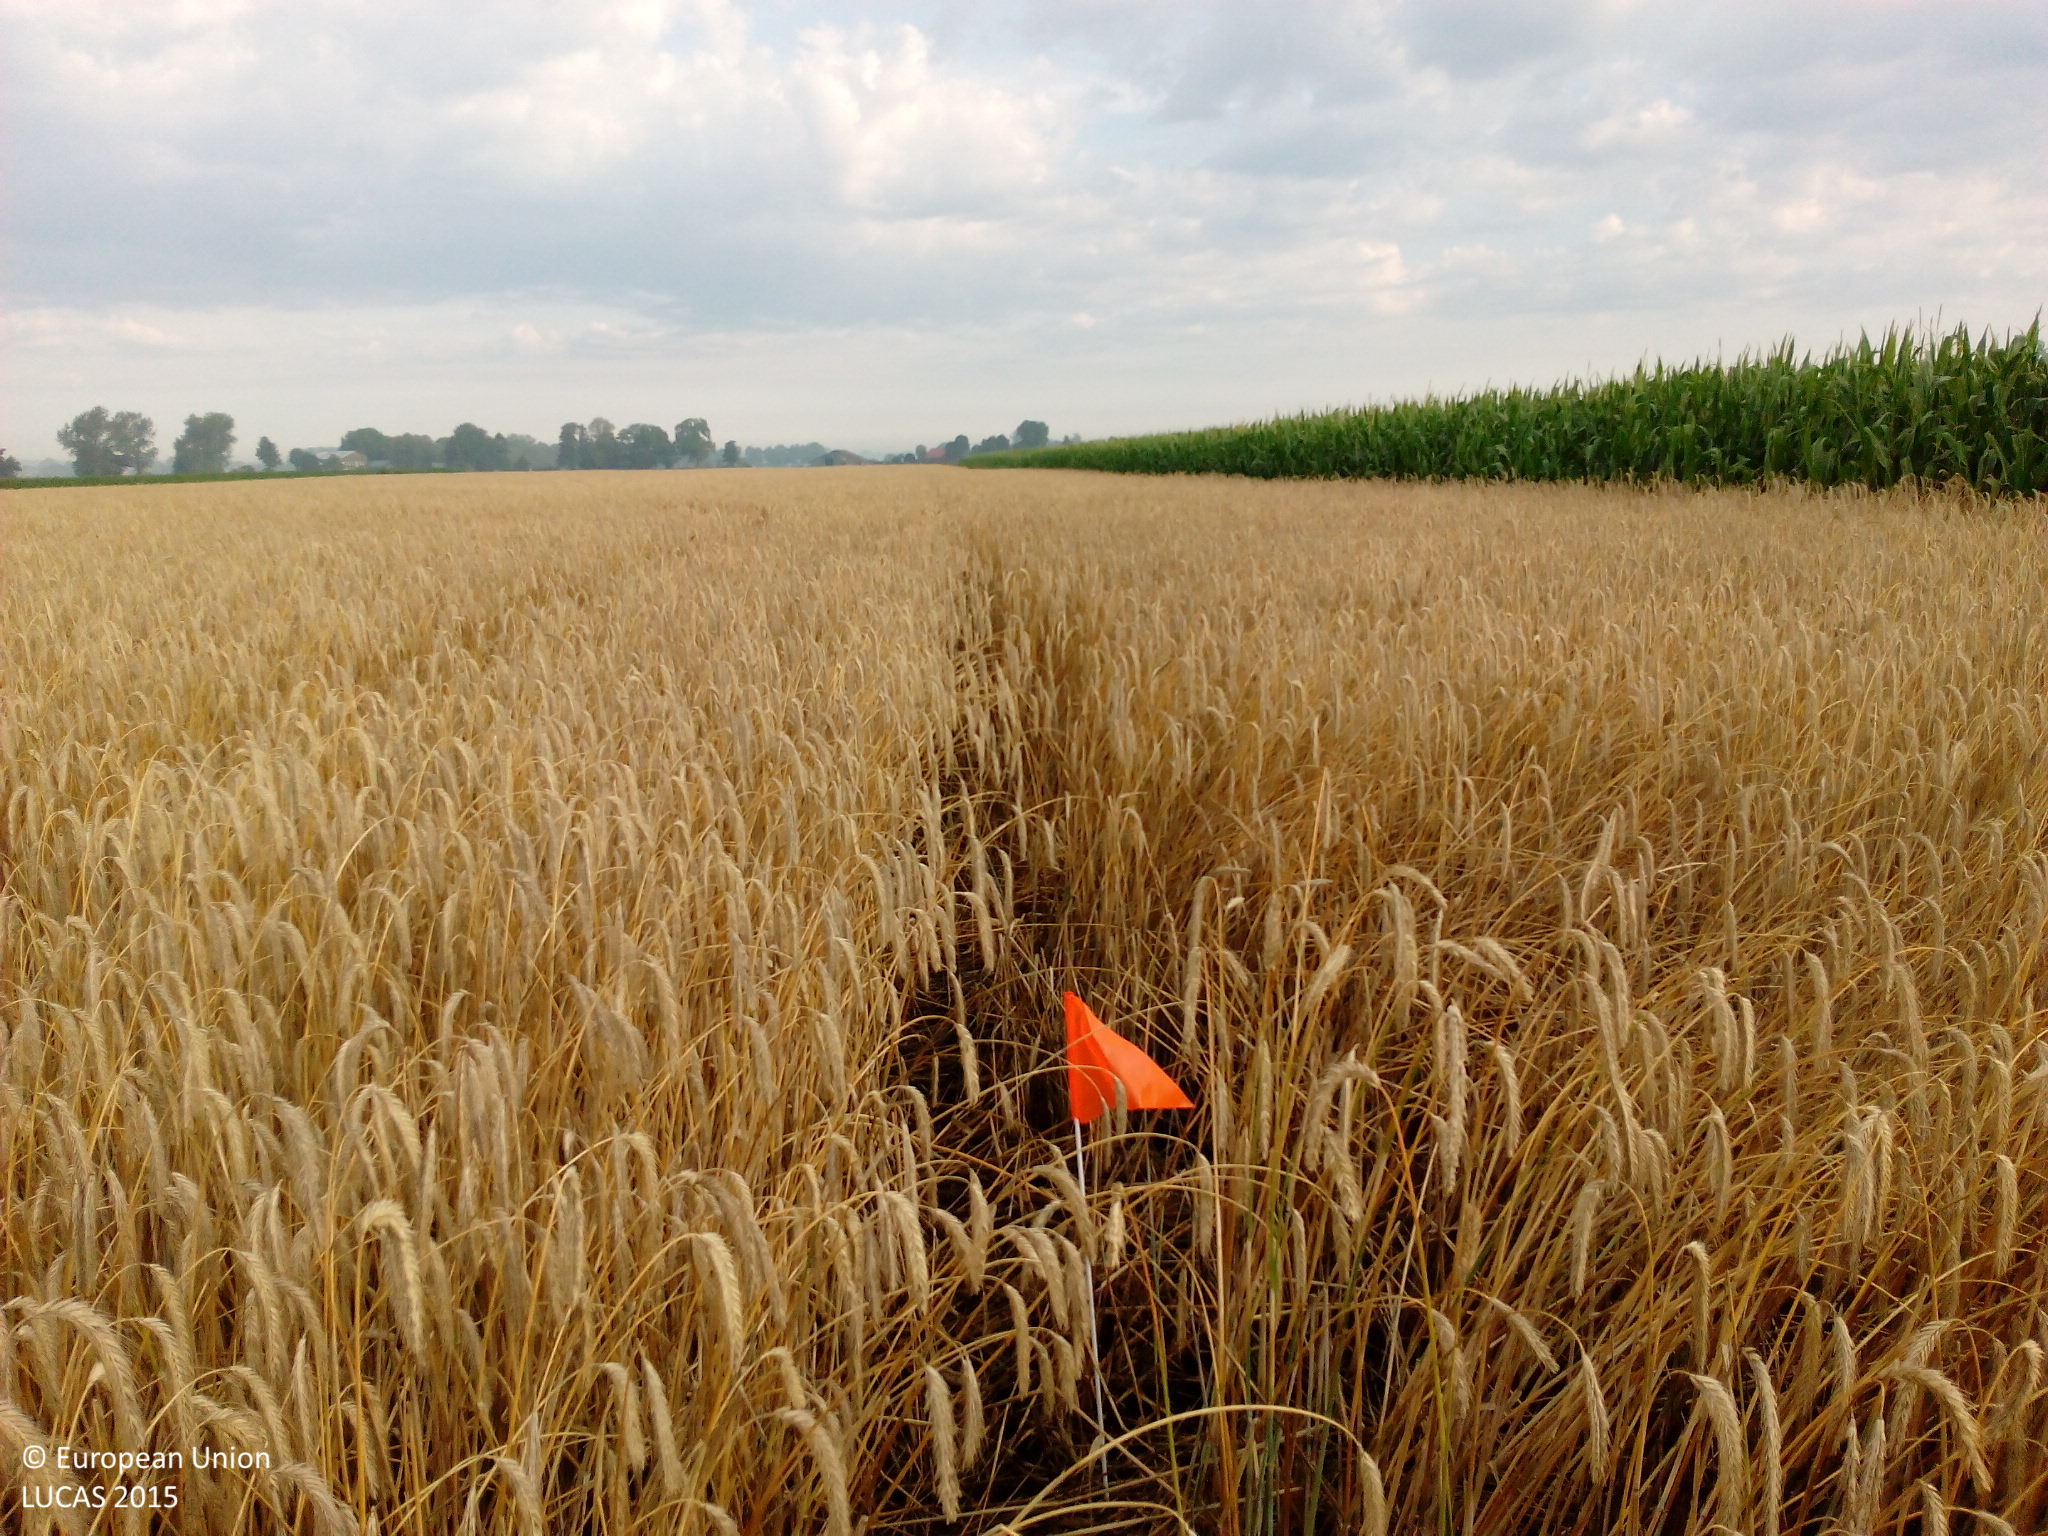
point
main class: Cropland
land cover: Rye
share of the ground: > 75 %
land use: Agriculture (excluding fallow land and kitchen gardens)
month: August
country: DE
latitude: 53.9046
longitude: 9.6501
